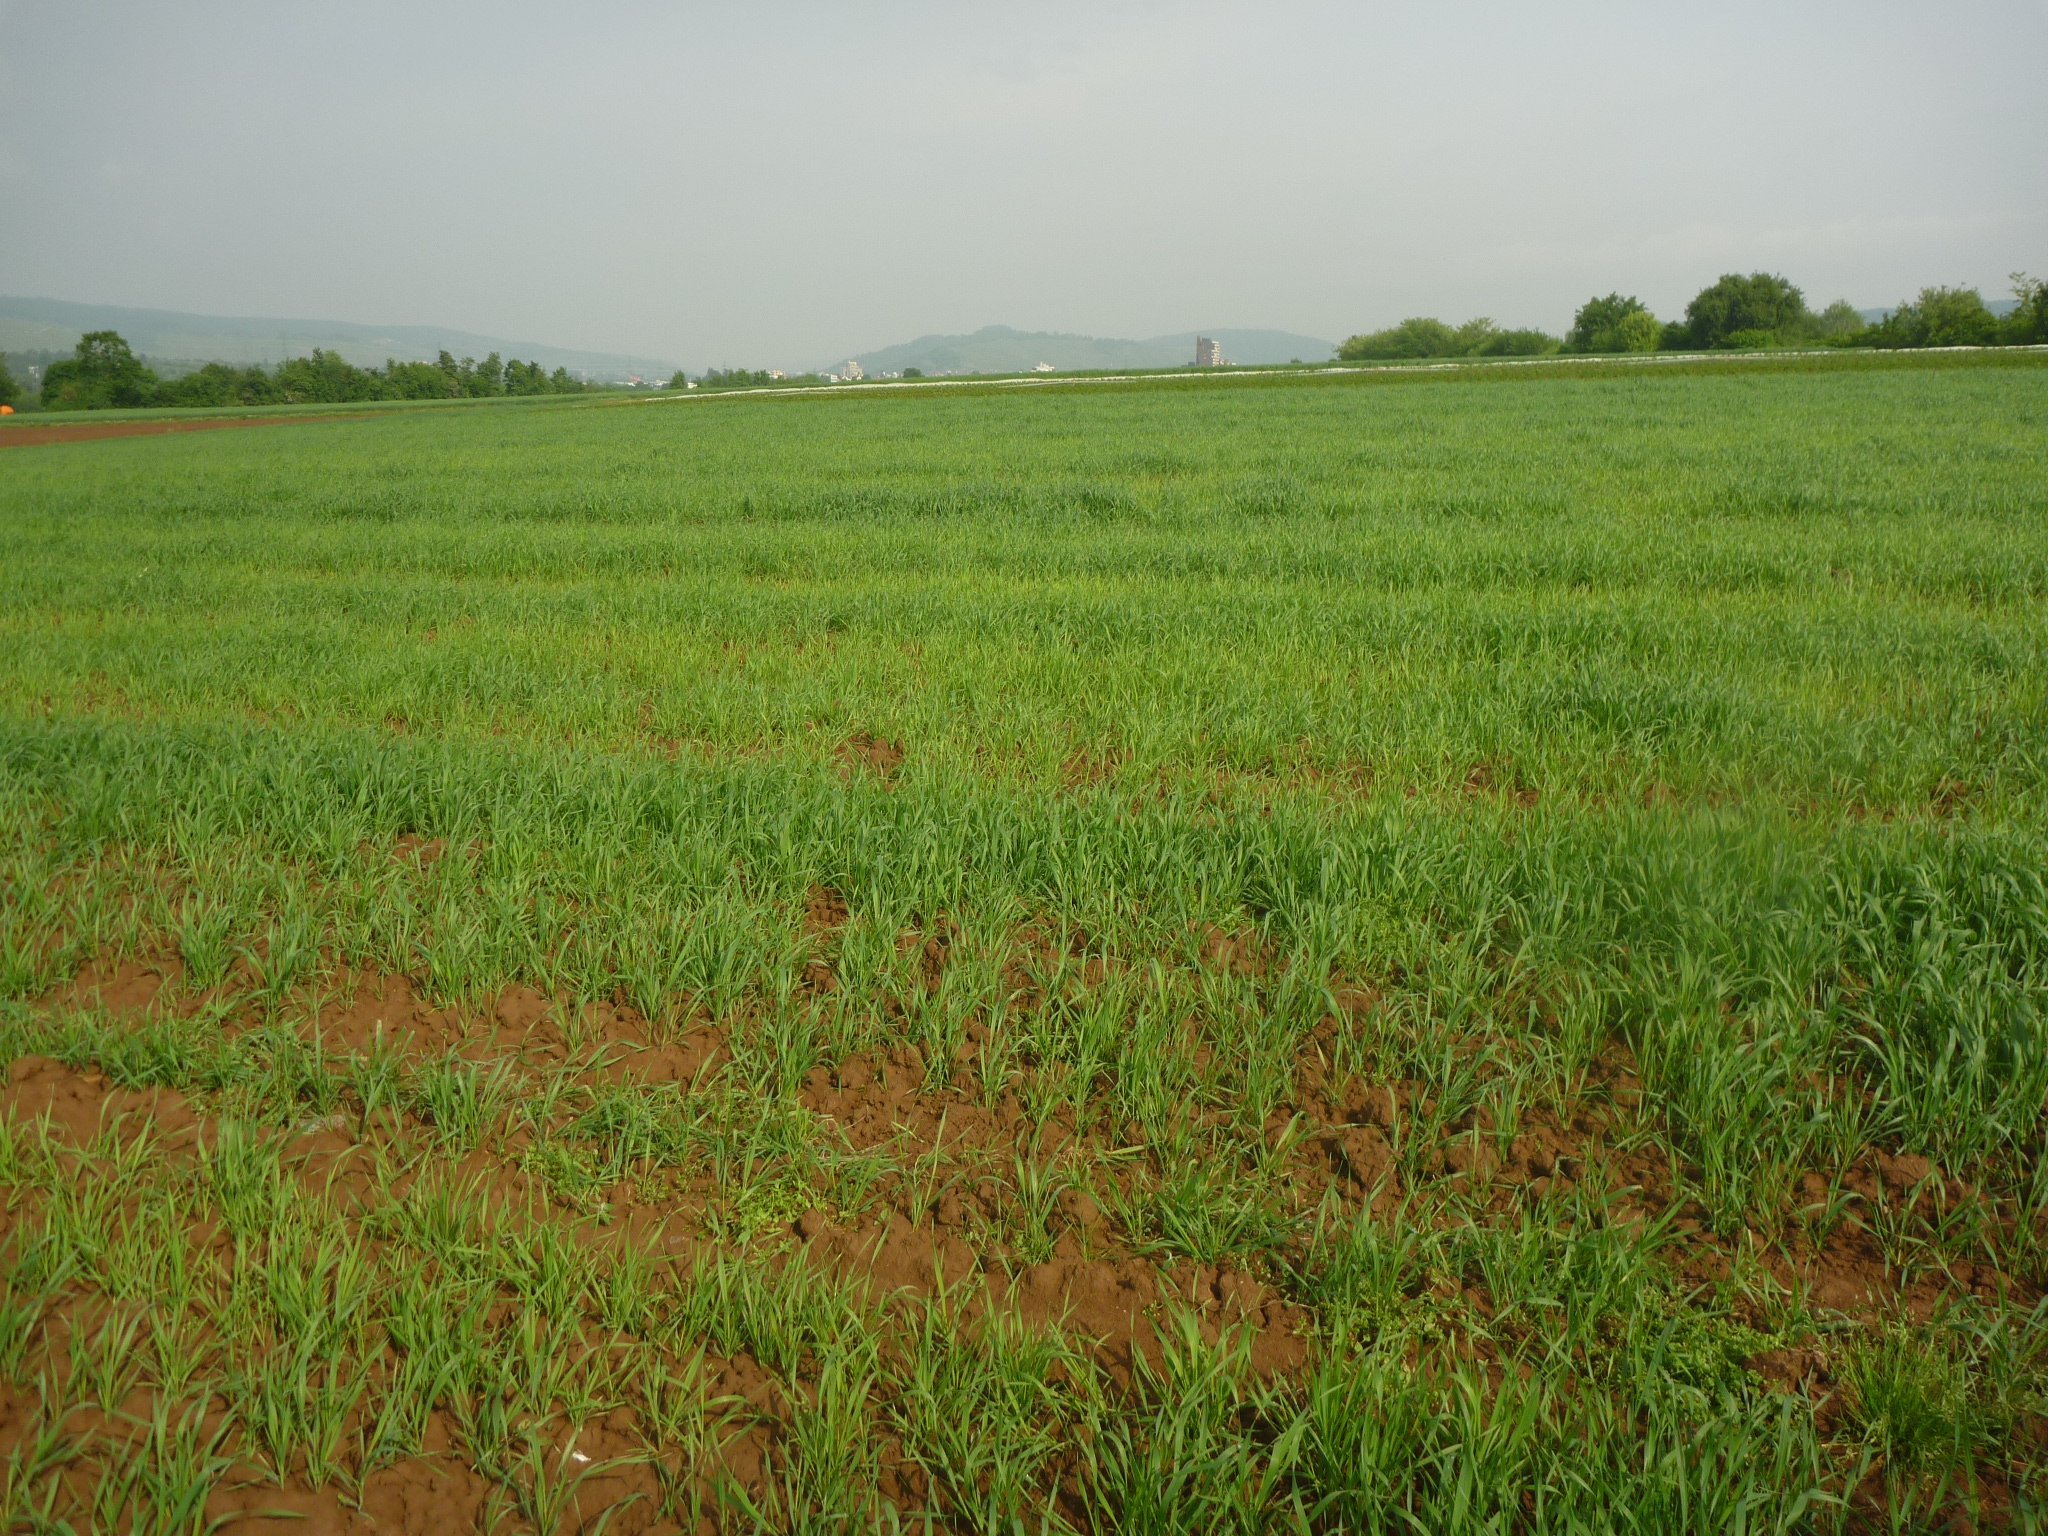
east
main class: Cropland
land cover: Common wheat
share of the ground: 25 - 50 %
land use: Agriculture (excluding fallow land and kitchen gardens)
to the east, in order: Common wheat; Other fresh vegetables; Common wheat; Grass margins; Paved roads, cycling and walking lanes; Grass margins; Other bare soil; Grass margins; Paved roads, cycling and walking lanes; Common wheat
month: May
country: DE
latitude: 48.8153
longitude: 9.3330
